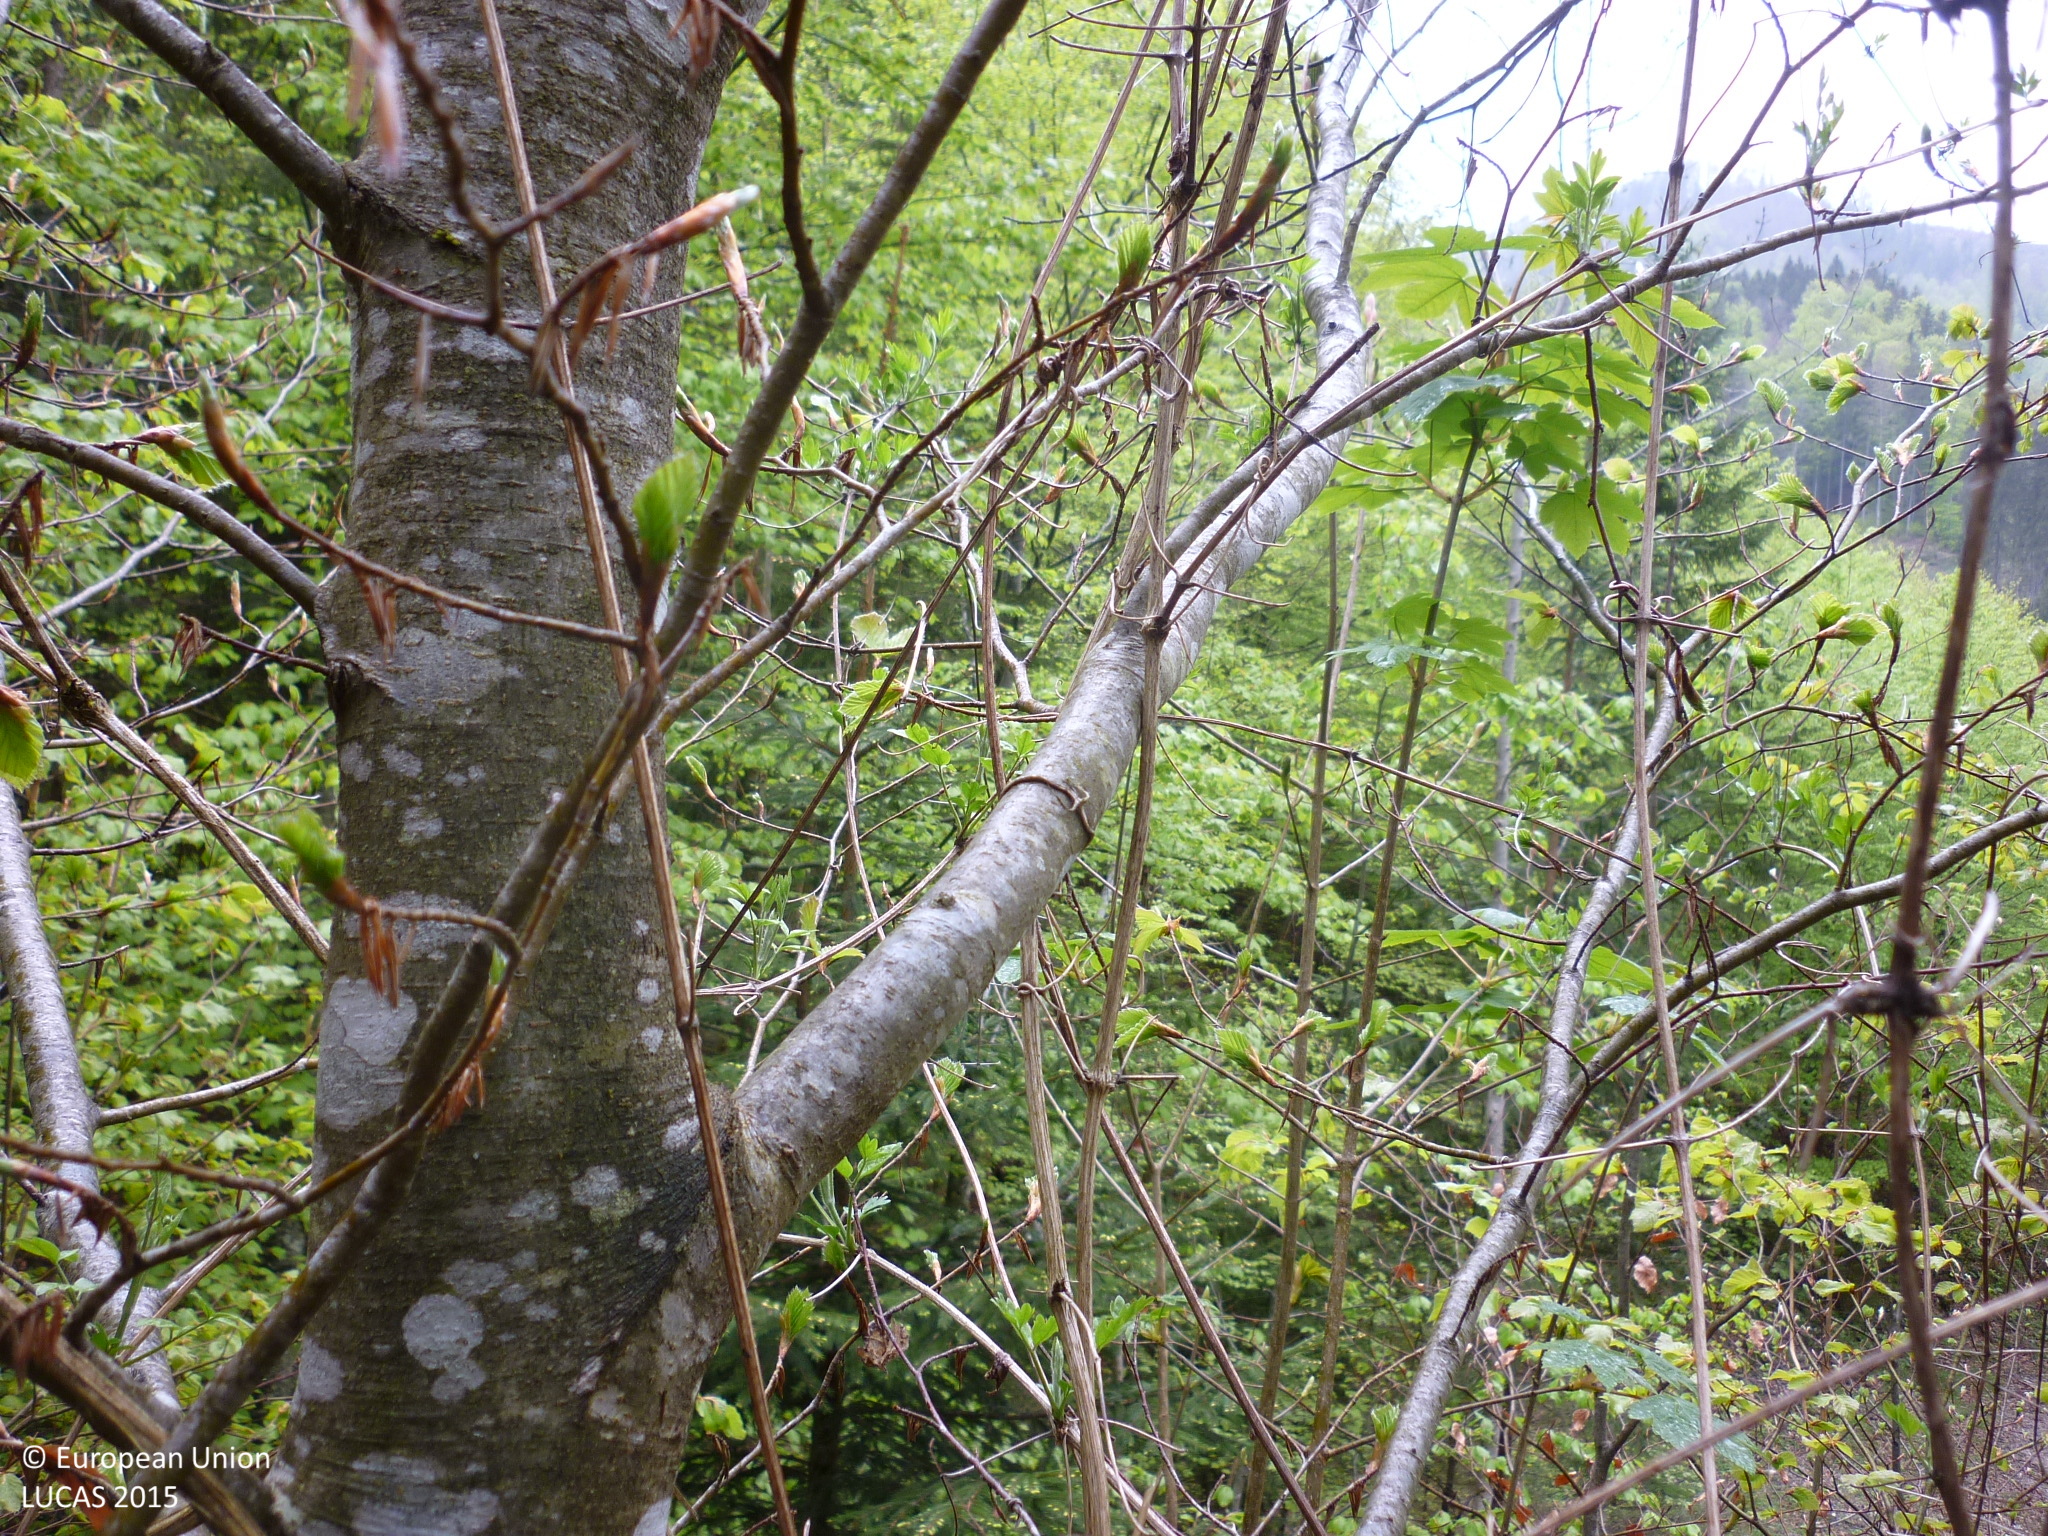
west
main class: Woodland
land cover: Broadleaved woodland
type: mountainous beech forest
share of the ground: > 75 %
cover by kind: broadleaved forest trees 90 %, coniferous forest trees 5 %, herbaceous plants 5 %
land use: Forestry
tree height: < 5 m
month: May
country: AT
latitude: 47.6917
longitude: 14.6763
